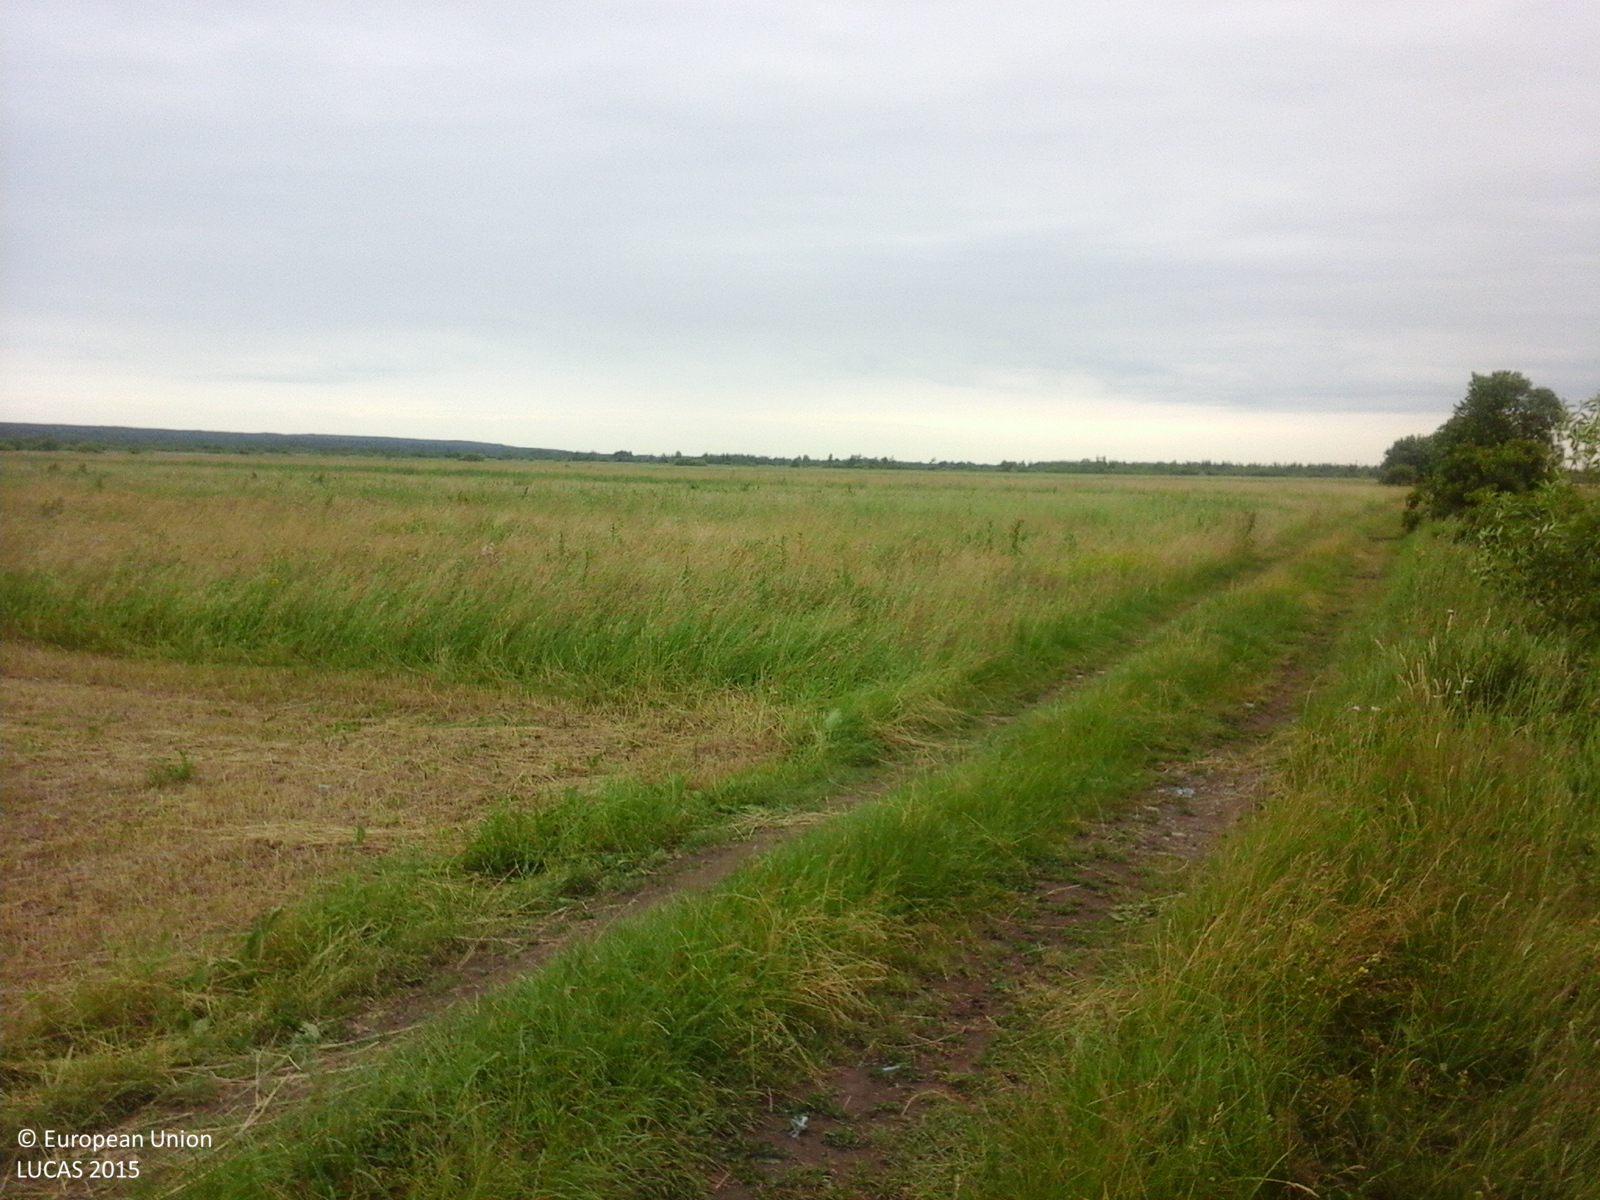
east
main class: Grassland
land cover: Grassland without tree/shrub cover
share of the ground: > 75 %
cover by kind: herbaceous plants 100 %
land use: Agriculture (excluding fallow land and kitchen gardens)
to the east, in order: Grass margins; Tracks; Grassland without tree/shrub cover; Tracks; Grassland without tree/shrub cover
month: June
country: RO
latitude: 47.9300
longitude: 25.7174
